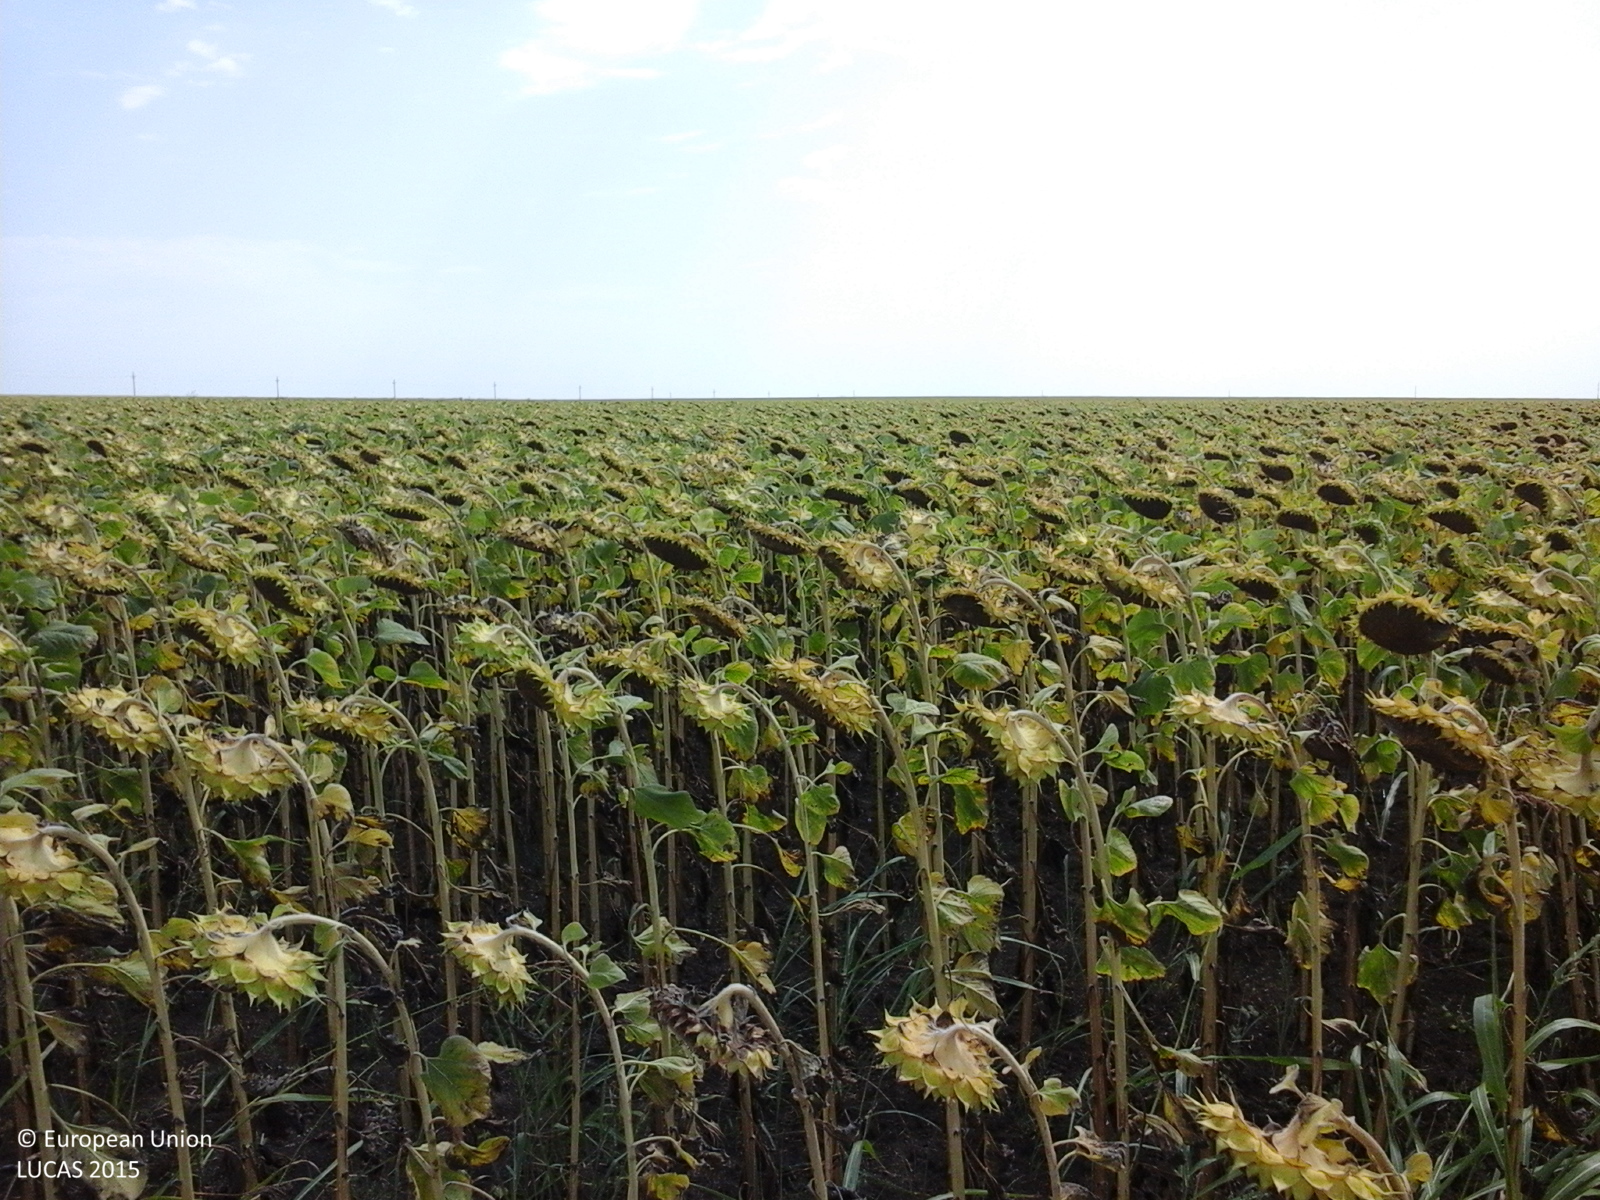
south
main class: Cropland
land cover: Sunflower
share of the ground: > 75 %
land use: Agriculture (excluding fallow land and kitchen gardens)
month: August
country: RO
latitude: 43.9098
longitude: 28.3799
